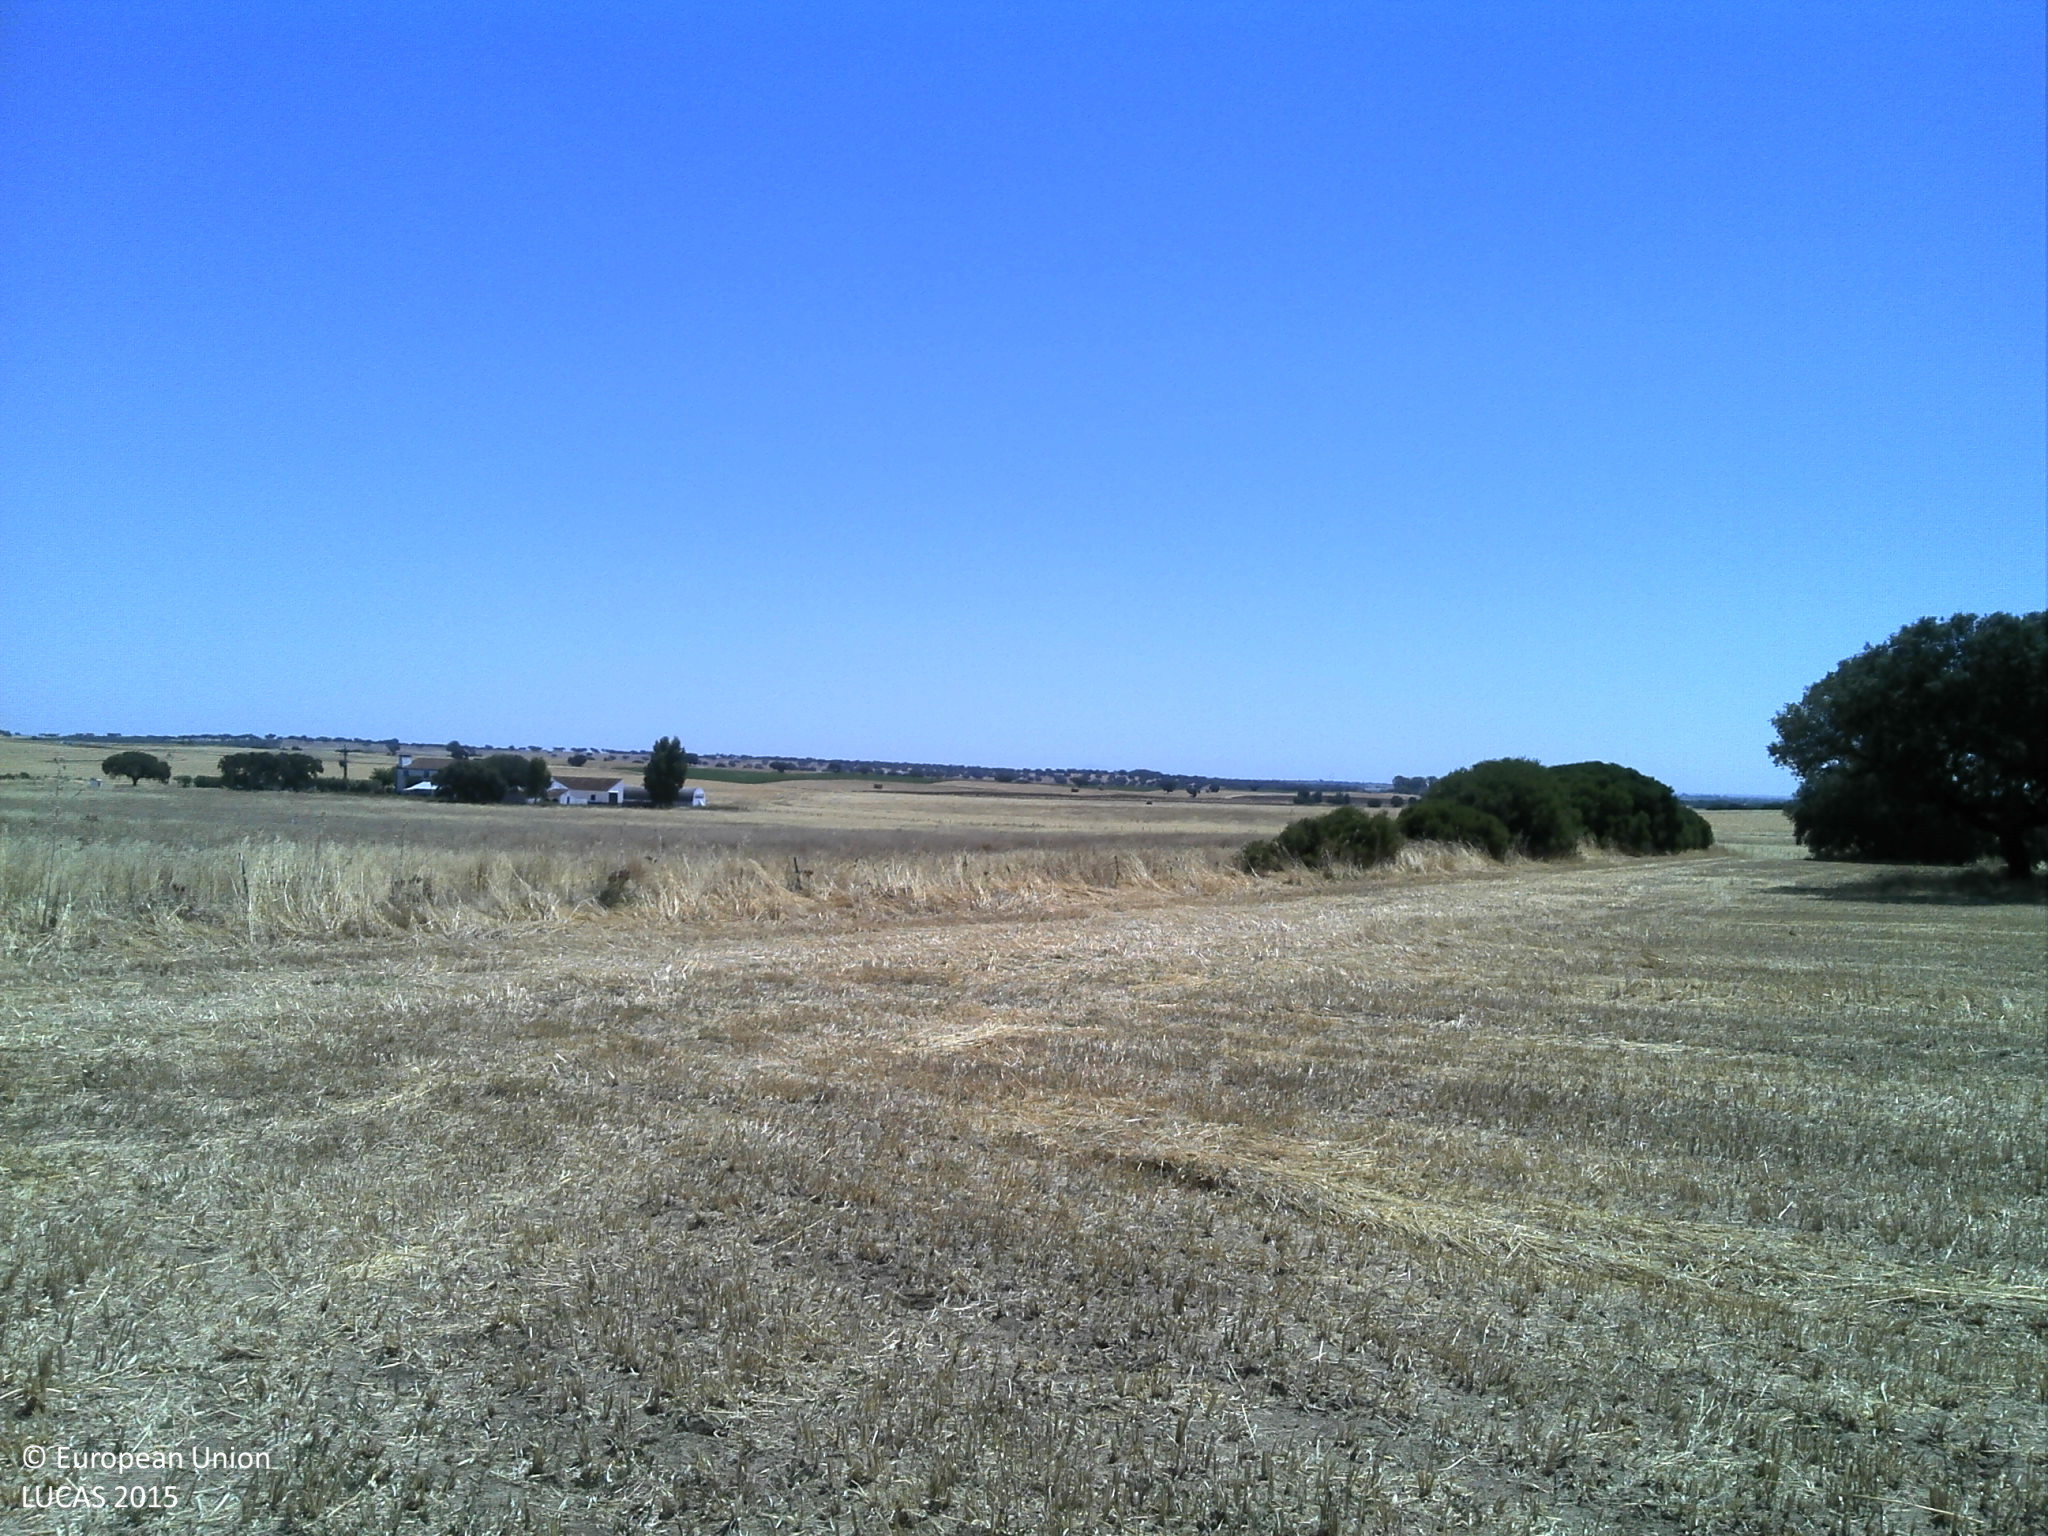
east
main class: Cropland
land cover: Oats
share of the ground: < 10 %
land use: Agriculture (excluding fallow land and kitchen gardens)
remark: Harvested field
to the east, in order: Oats; Grass margins; Spontaneously vegetated surfaces
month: July
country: PT
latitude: 38.9734
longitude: -7.0050
